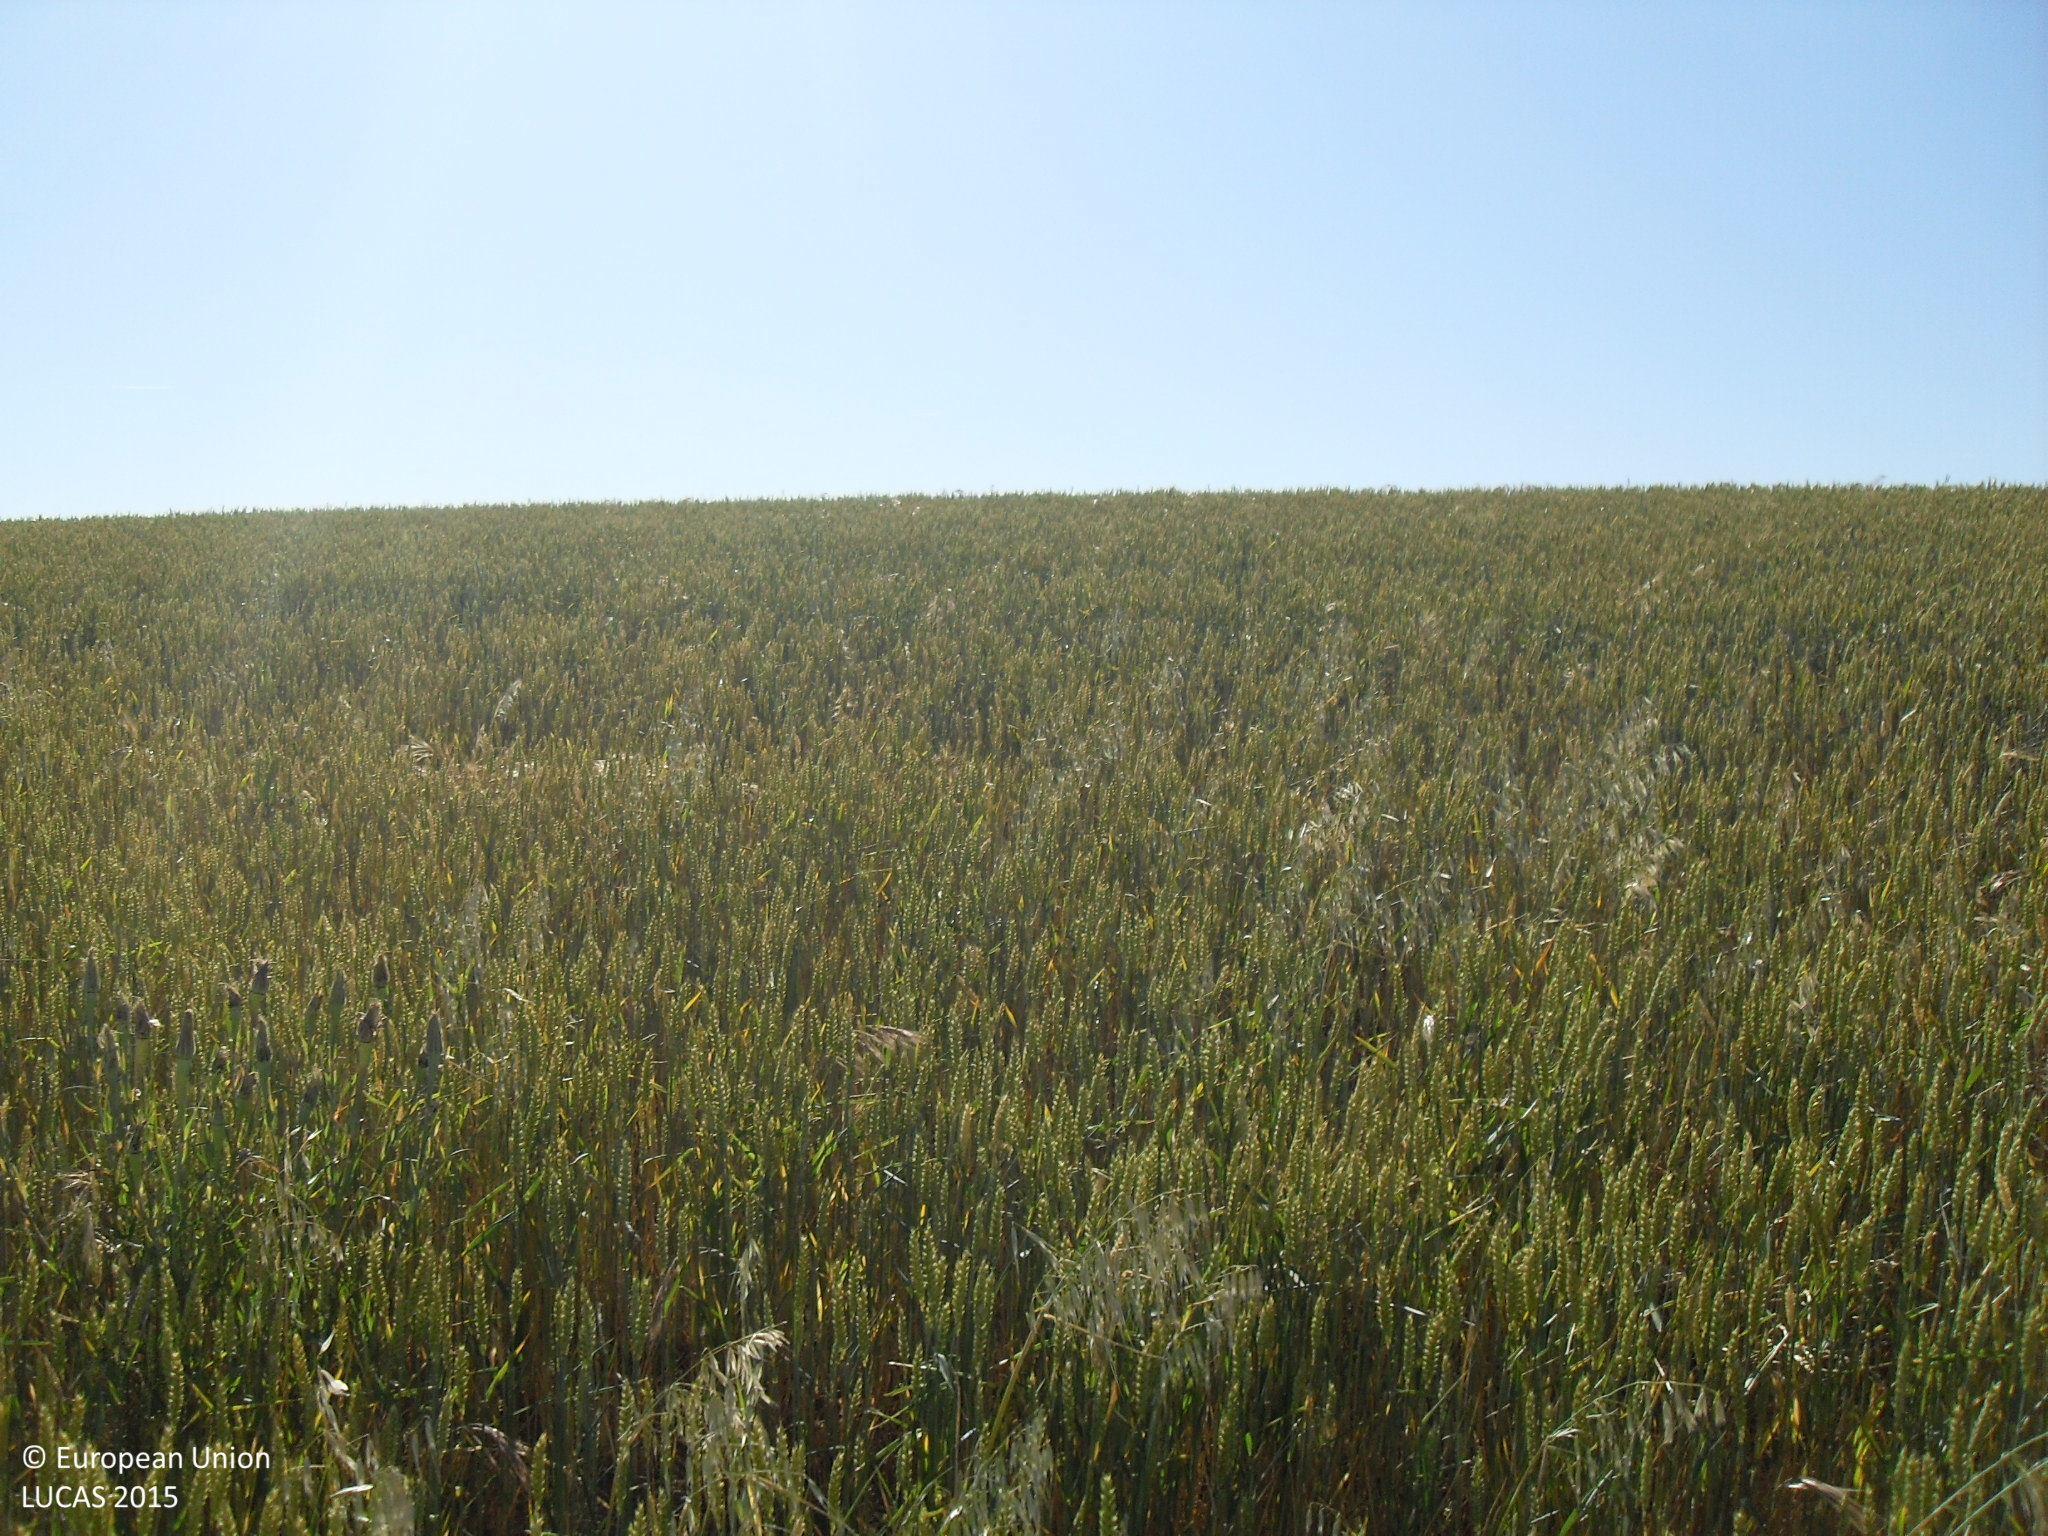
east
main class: Cropland
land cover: Common wheat
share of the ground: > 75 %
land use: Agriculture (excluding fallow land and kitchen gardens)
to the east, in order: Common wheat; Other bare soil
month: May
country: ES
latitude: 41.1657
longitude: -5.2199
